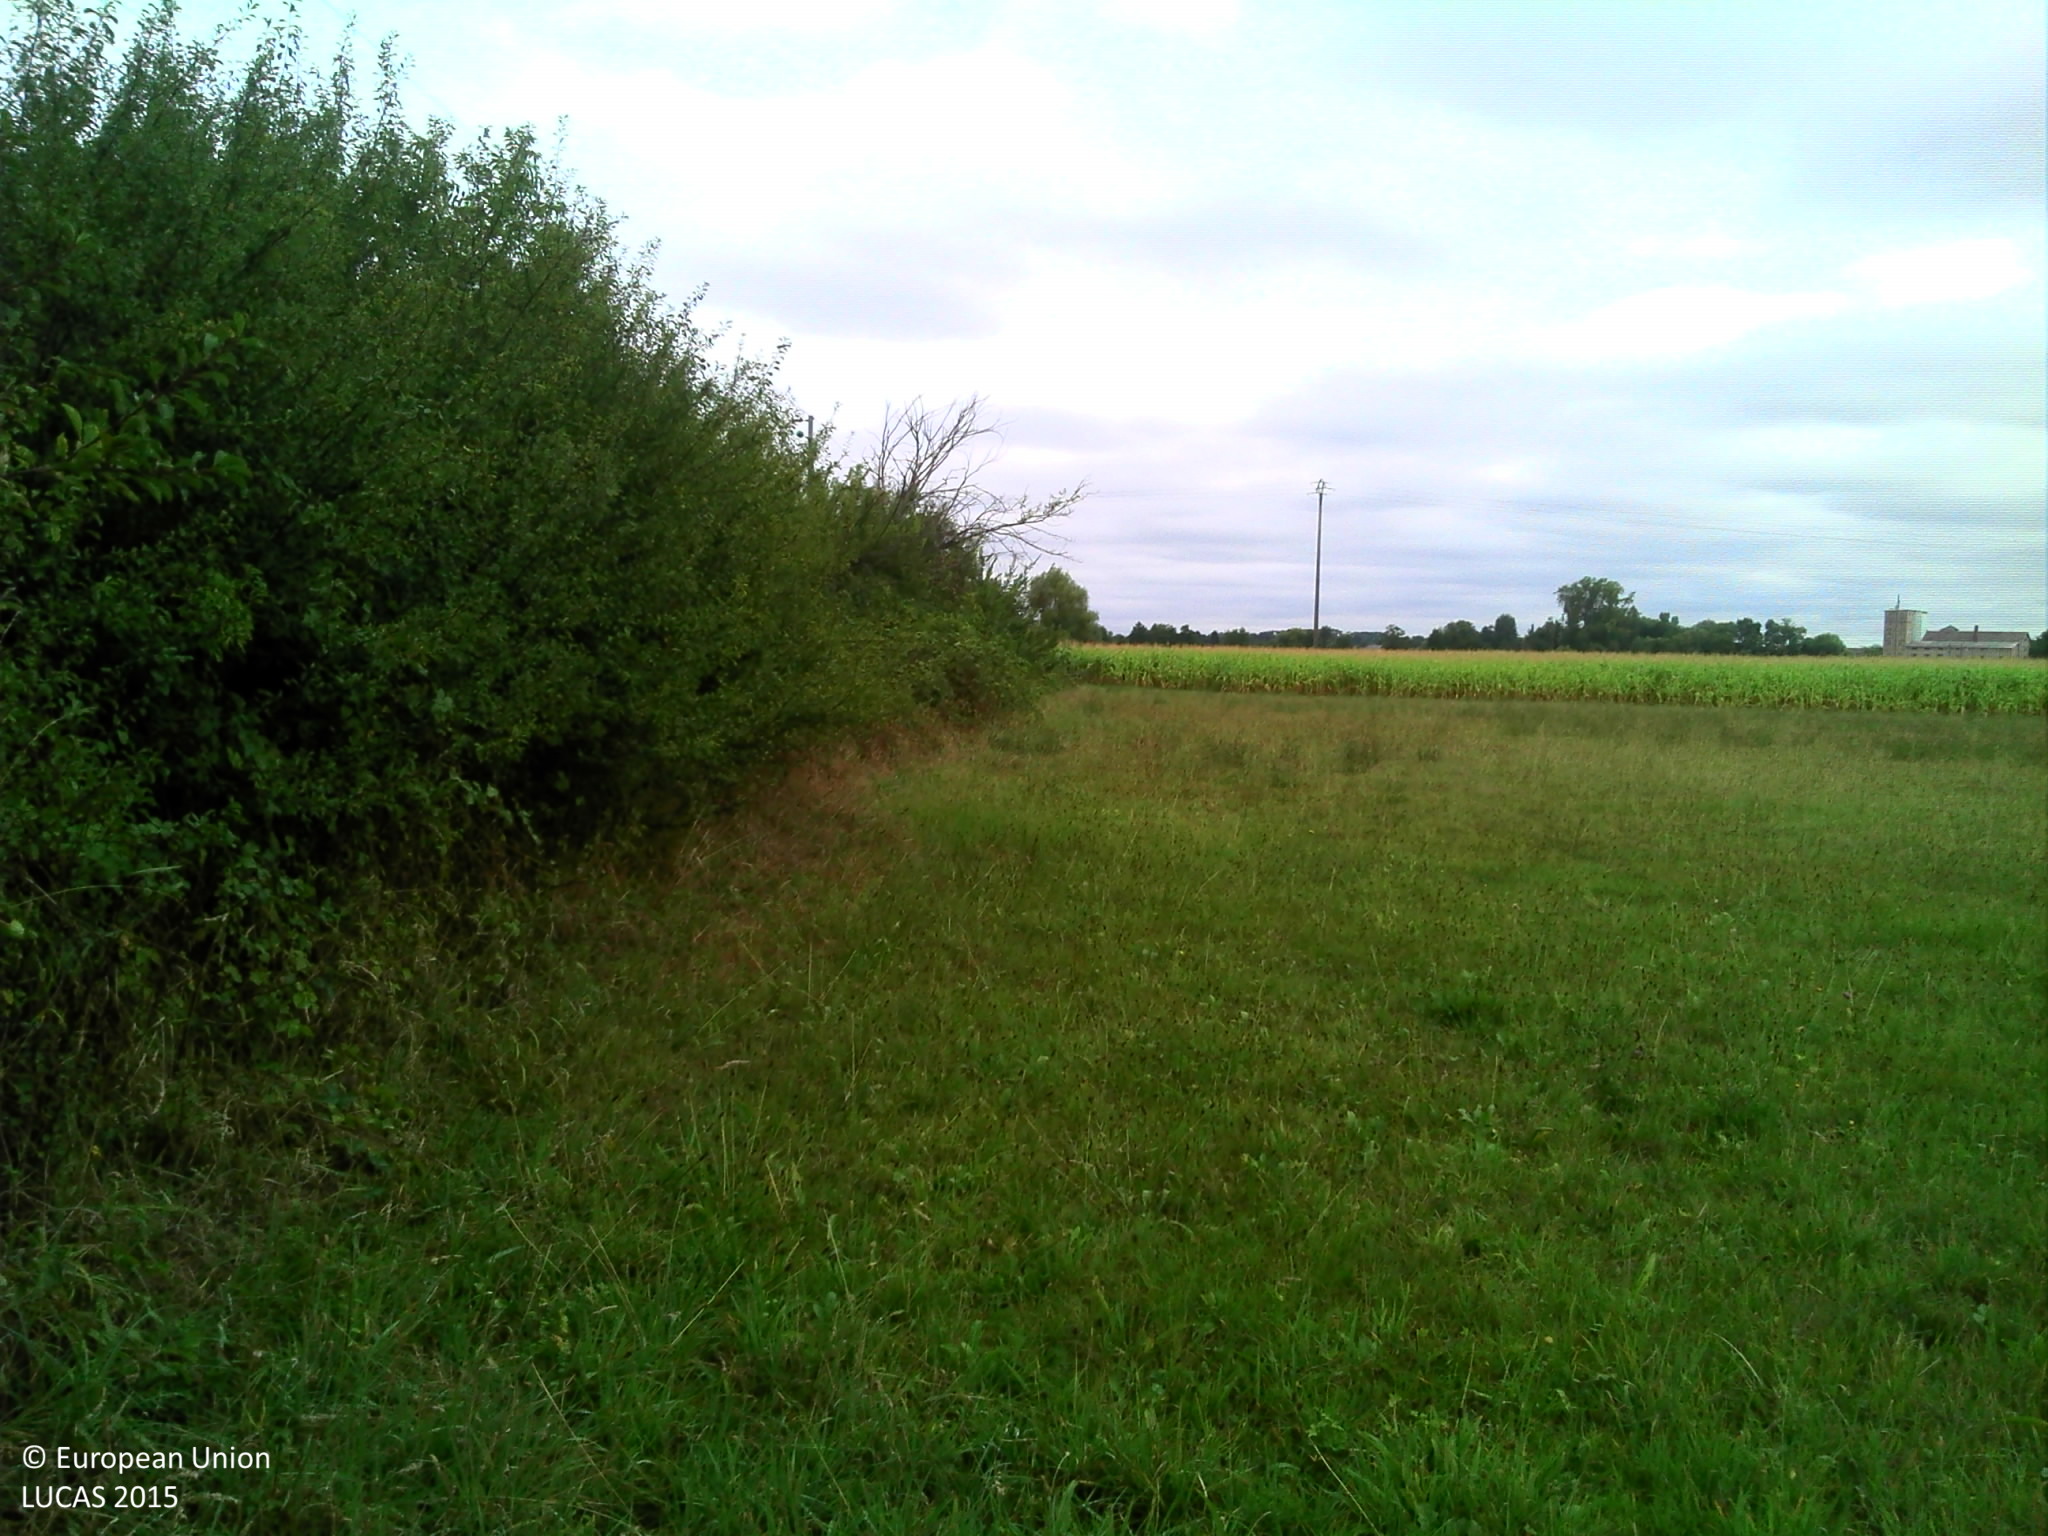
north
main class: Shrubland
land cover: Shrubland without tree cover
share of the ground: > 75 %
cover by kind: shrubs 90 %, herbaceous plants 10 %
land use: Railway transport
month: August
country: FR
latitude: 48.7216
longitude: 7.7035
